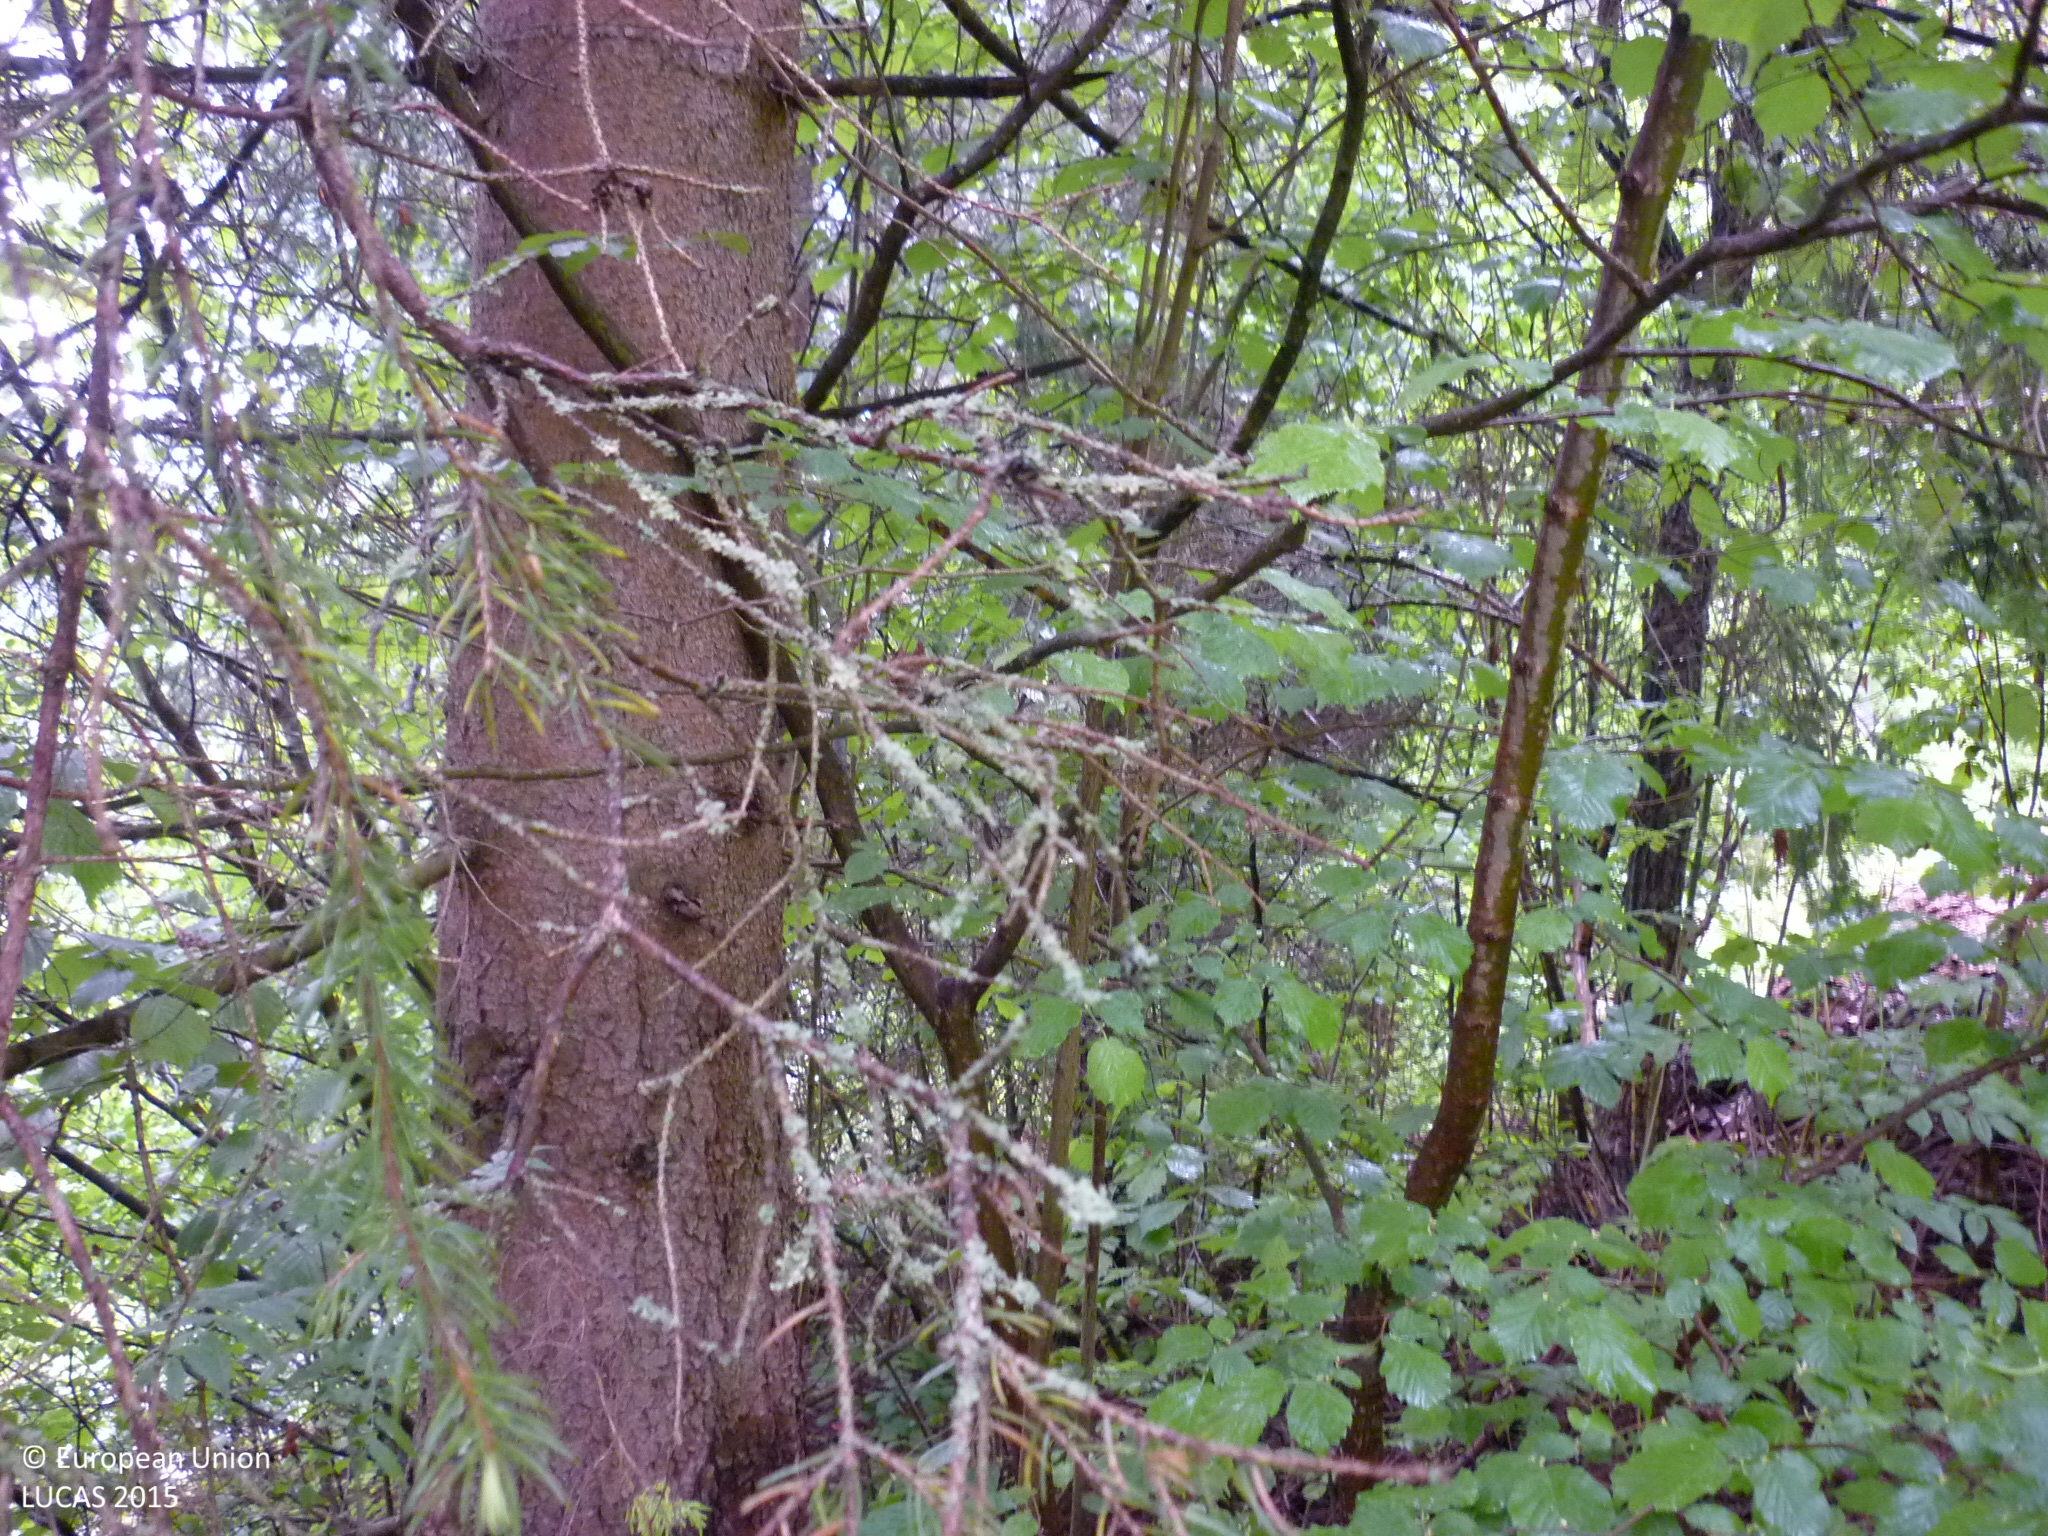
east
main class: Woodland
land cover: Spruce dominated mixed woodland
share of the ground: > 75 %
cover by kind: coniferous forest trees 45 %, broadleaved forest trees 30 %, herbaceous plants 25 %
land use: Forestry
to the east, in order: Spruce dominated mixed woodland; Paved roads, cycling and walking lanes; Fences; Spruce dominated mixed woodland; Tracks; Grassland without tree/shrub cover; Fences; Grassland without tree/shrub cover; Fences; Shrubland with sparse tree cover; Fences; Spruce dominated coniferous woodland; Paved roads, cycling and walking lanes; Fences; Grassland without tree/shrub cover; Fences; Broadleaved woodland; Inland fresh running water; Broadleaved woodland
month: May
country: AT
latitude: 47.1032
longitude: 14.0696
